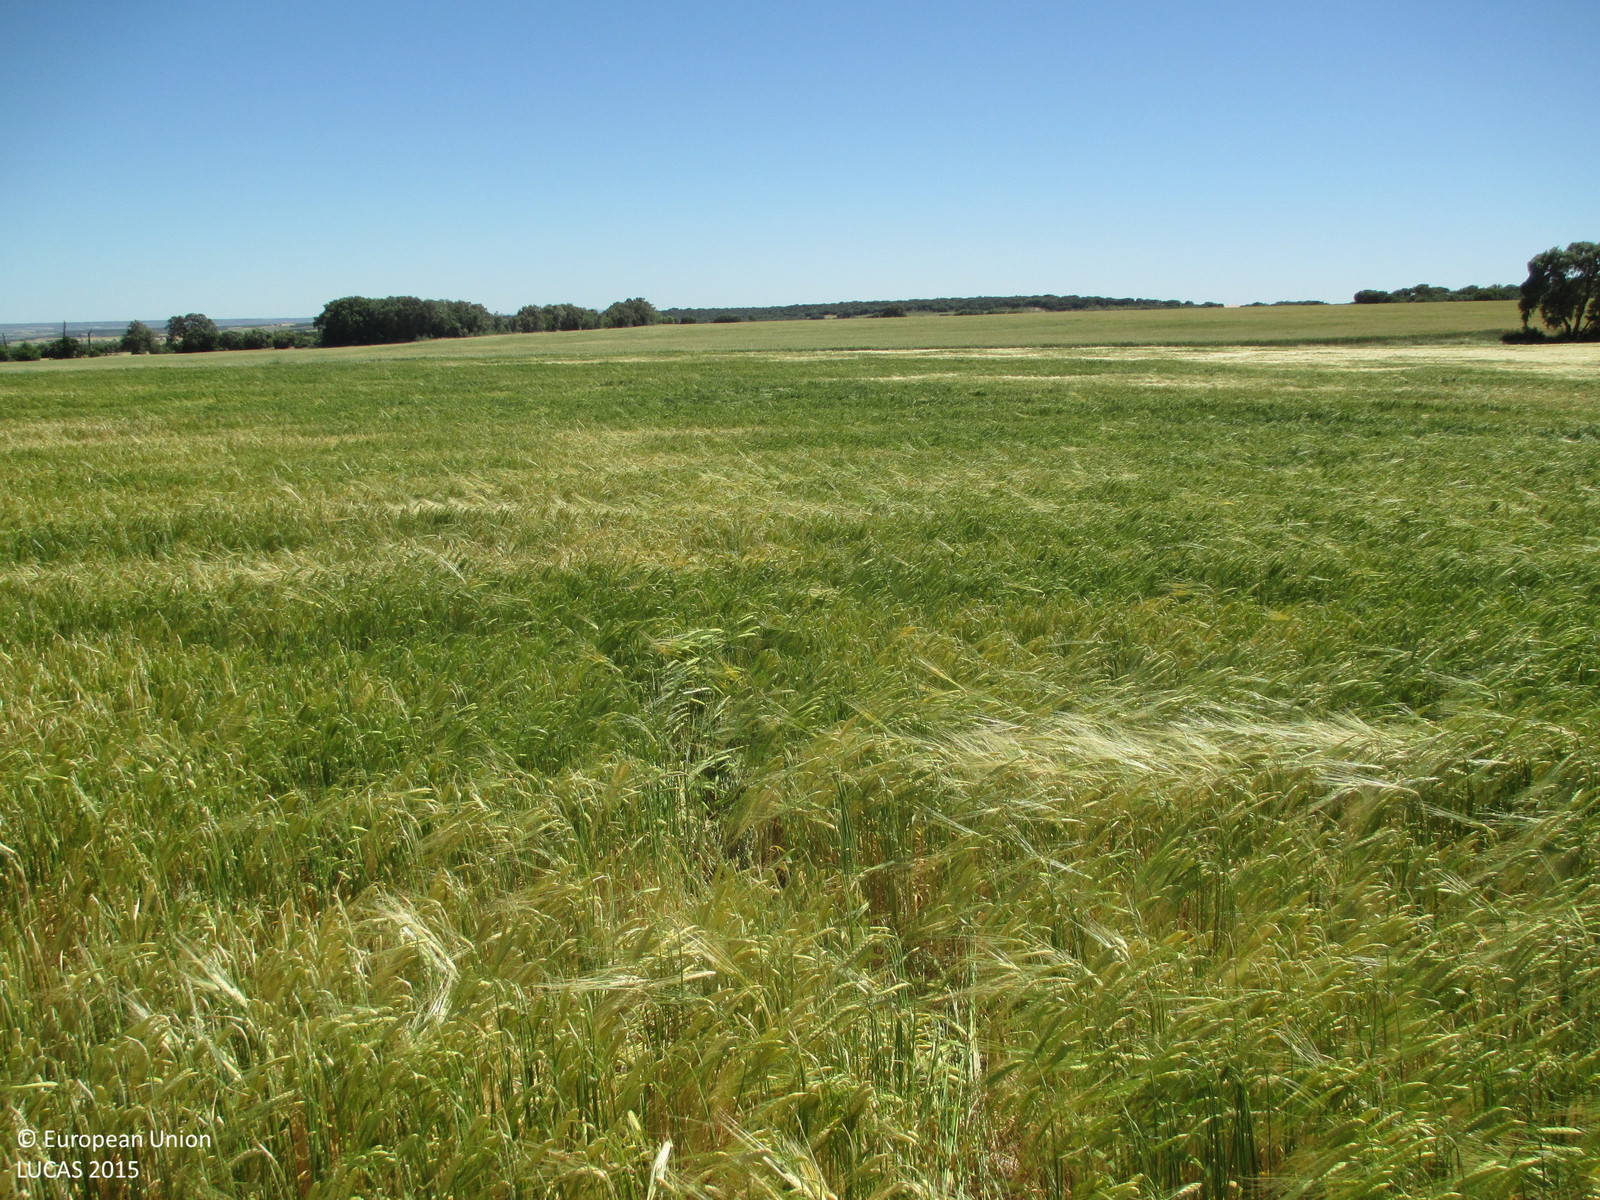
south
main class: Cropland
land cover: Barley
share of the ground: > 75 %
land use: Agriculture (excluding fallow land and kitchen gardens)
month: May
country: ES
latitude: 42.0284
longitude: -0.2021
